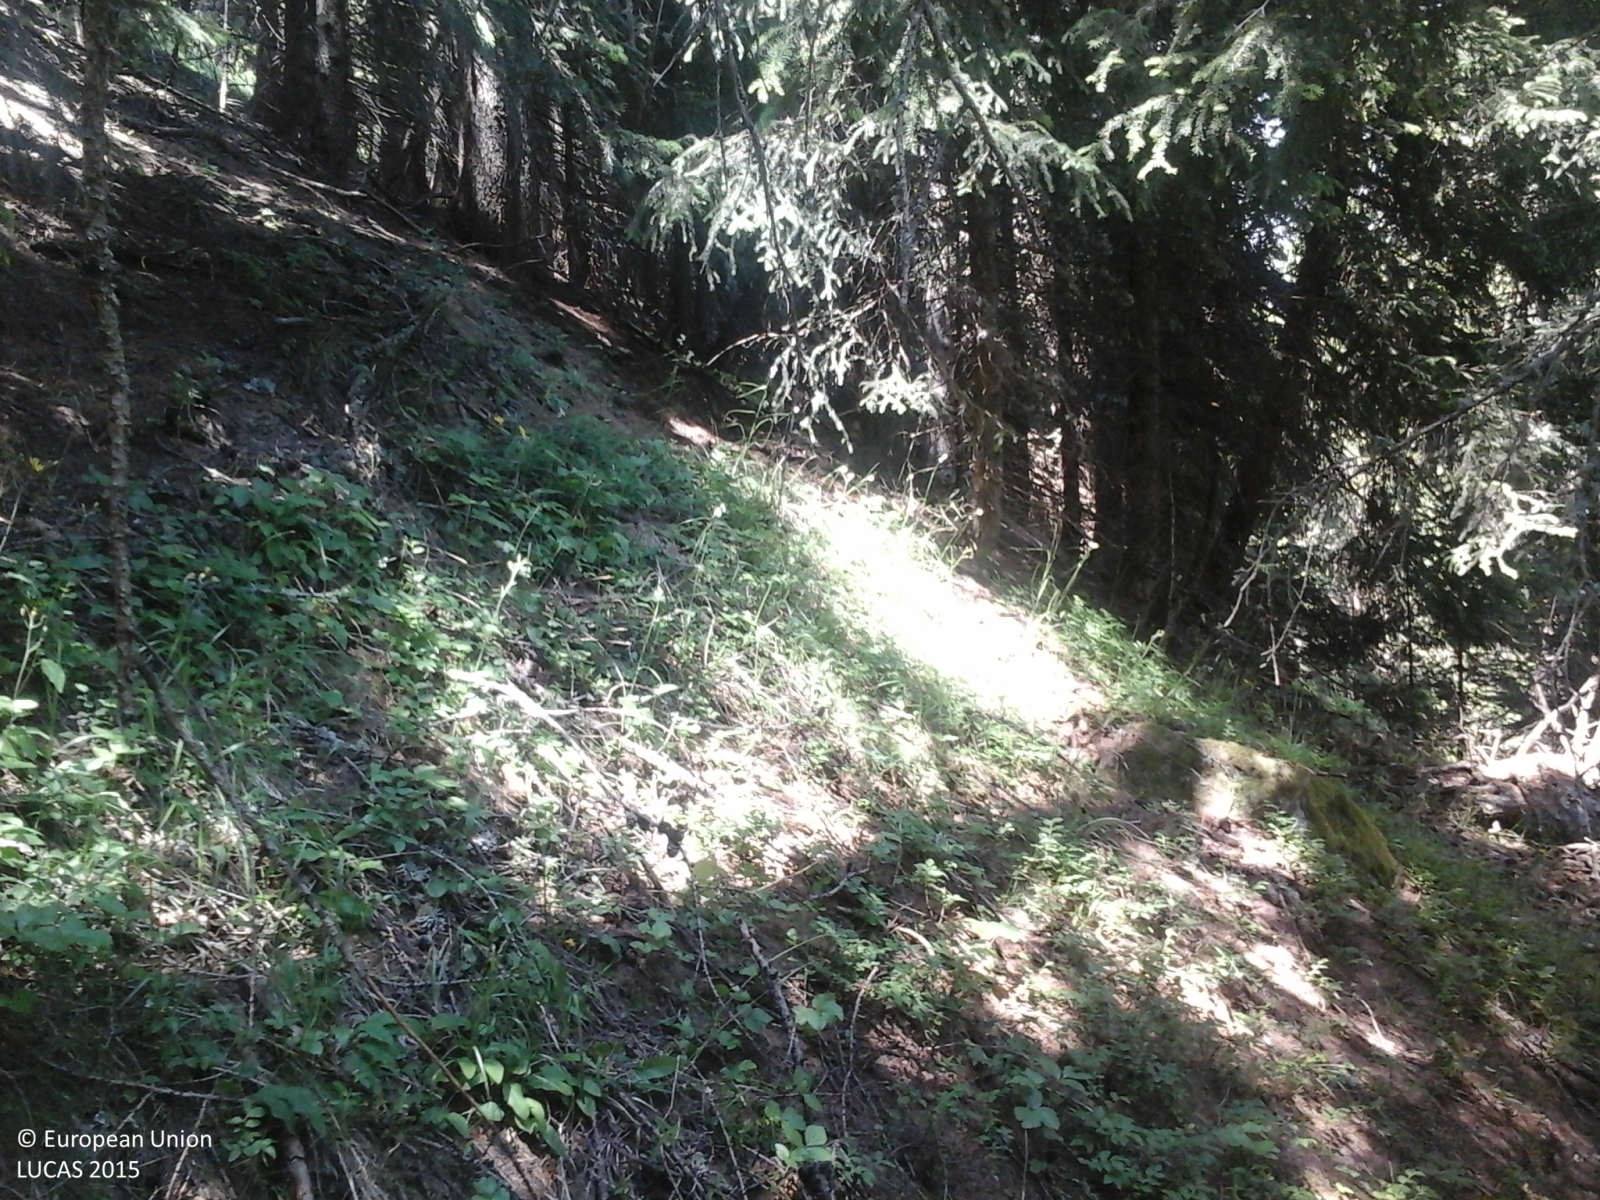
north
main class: Woodland
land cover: Other coniferous woodland
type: alpine coniferous forest
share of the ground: > 75 %
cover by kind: coniferous forest trees 100 %
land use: Forestry
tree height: > 5 m
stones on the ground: < 10 %
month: July
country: IT
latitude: 45.8033
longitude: 7.6743
